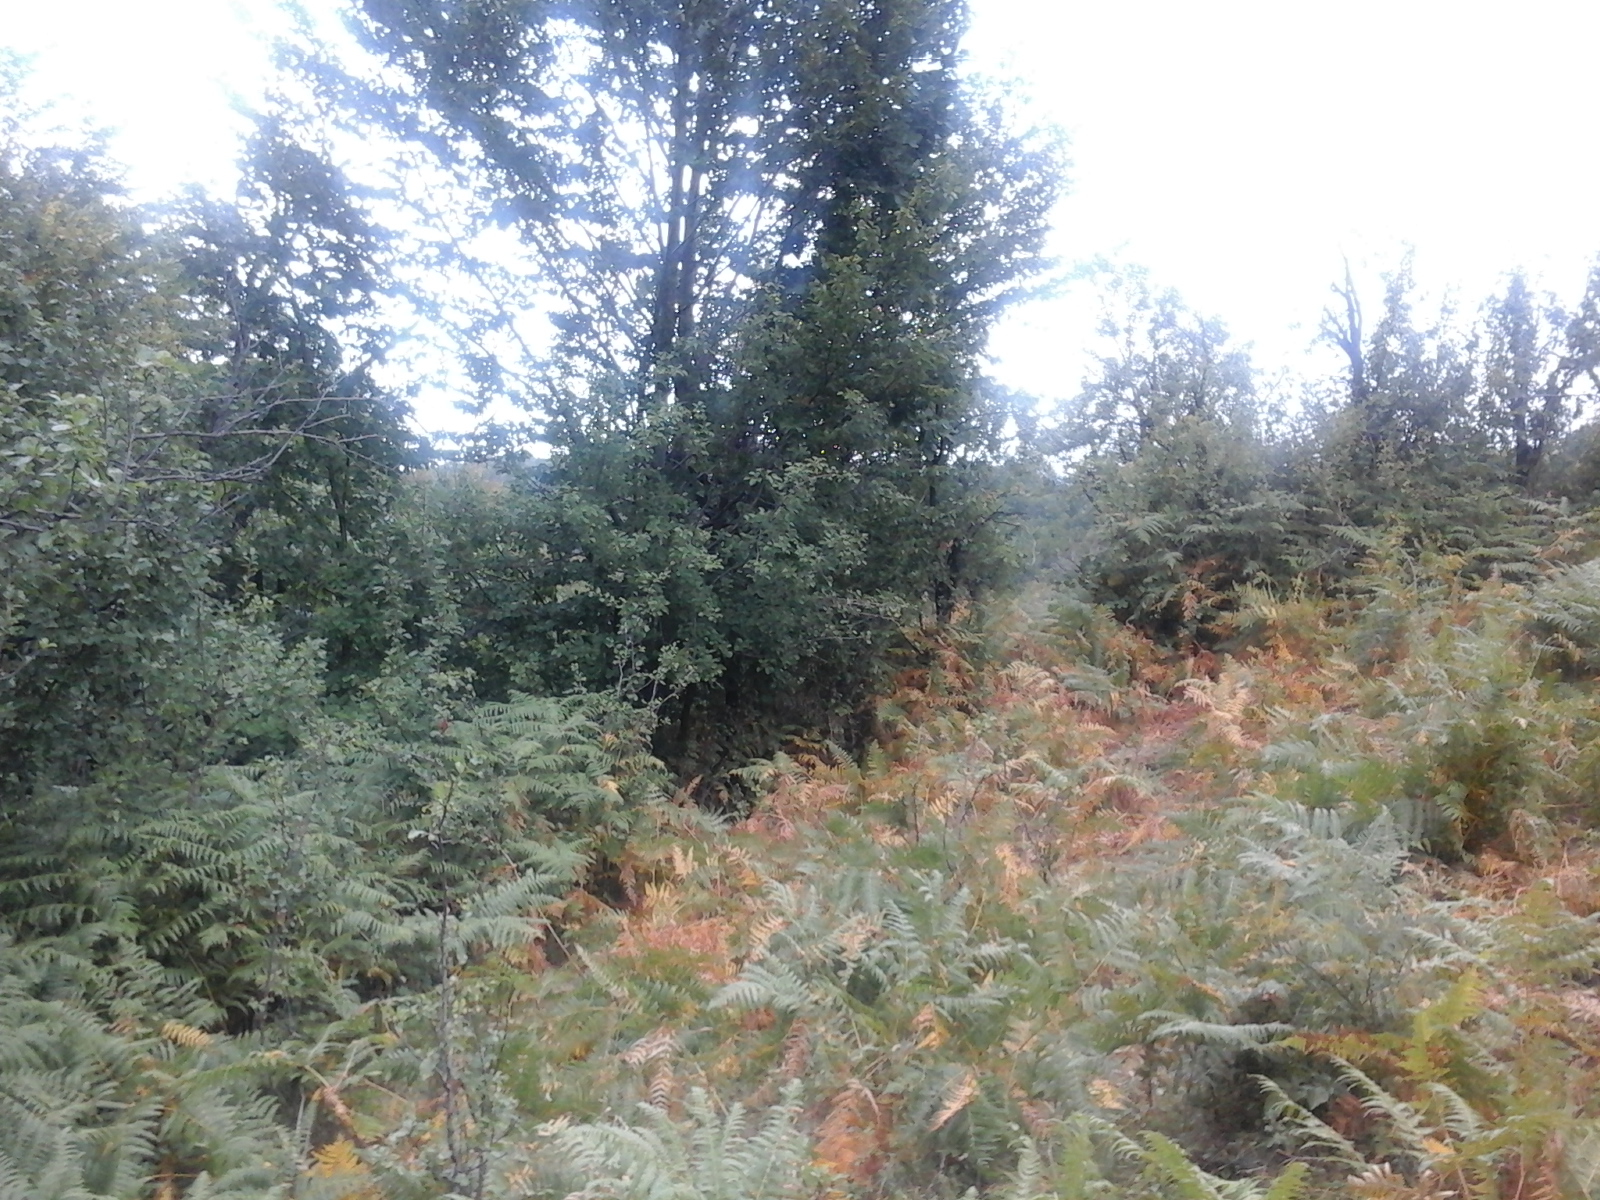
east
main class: Grassland
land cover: Grassland with sparse tree/shrub cover
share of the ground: > 75 %
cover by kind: herbaceous plants 95 %, broadleaved forest trees 5 %
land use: Agriculture (excluding fallow land and kitchen gardens)
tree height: > 5 m
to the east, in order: Grassland with sparse tree/shrub cover; Broadleaved woodland
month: August
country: RO
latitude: 44.9487
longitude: 22.7322
